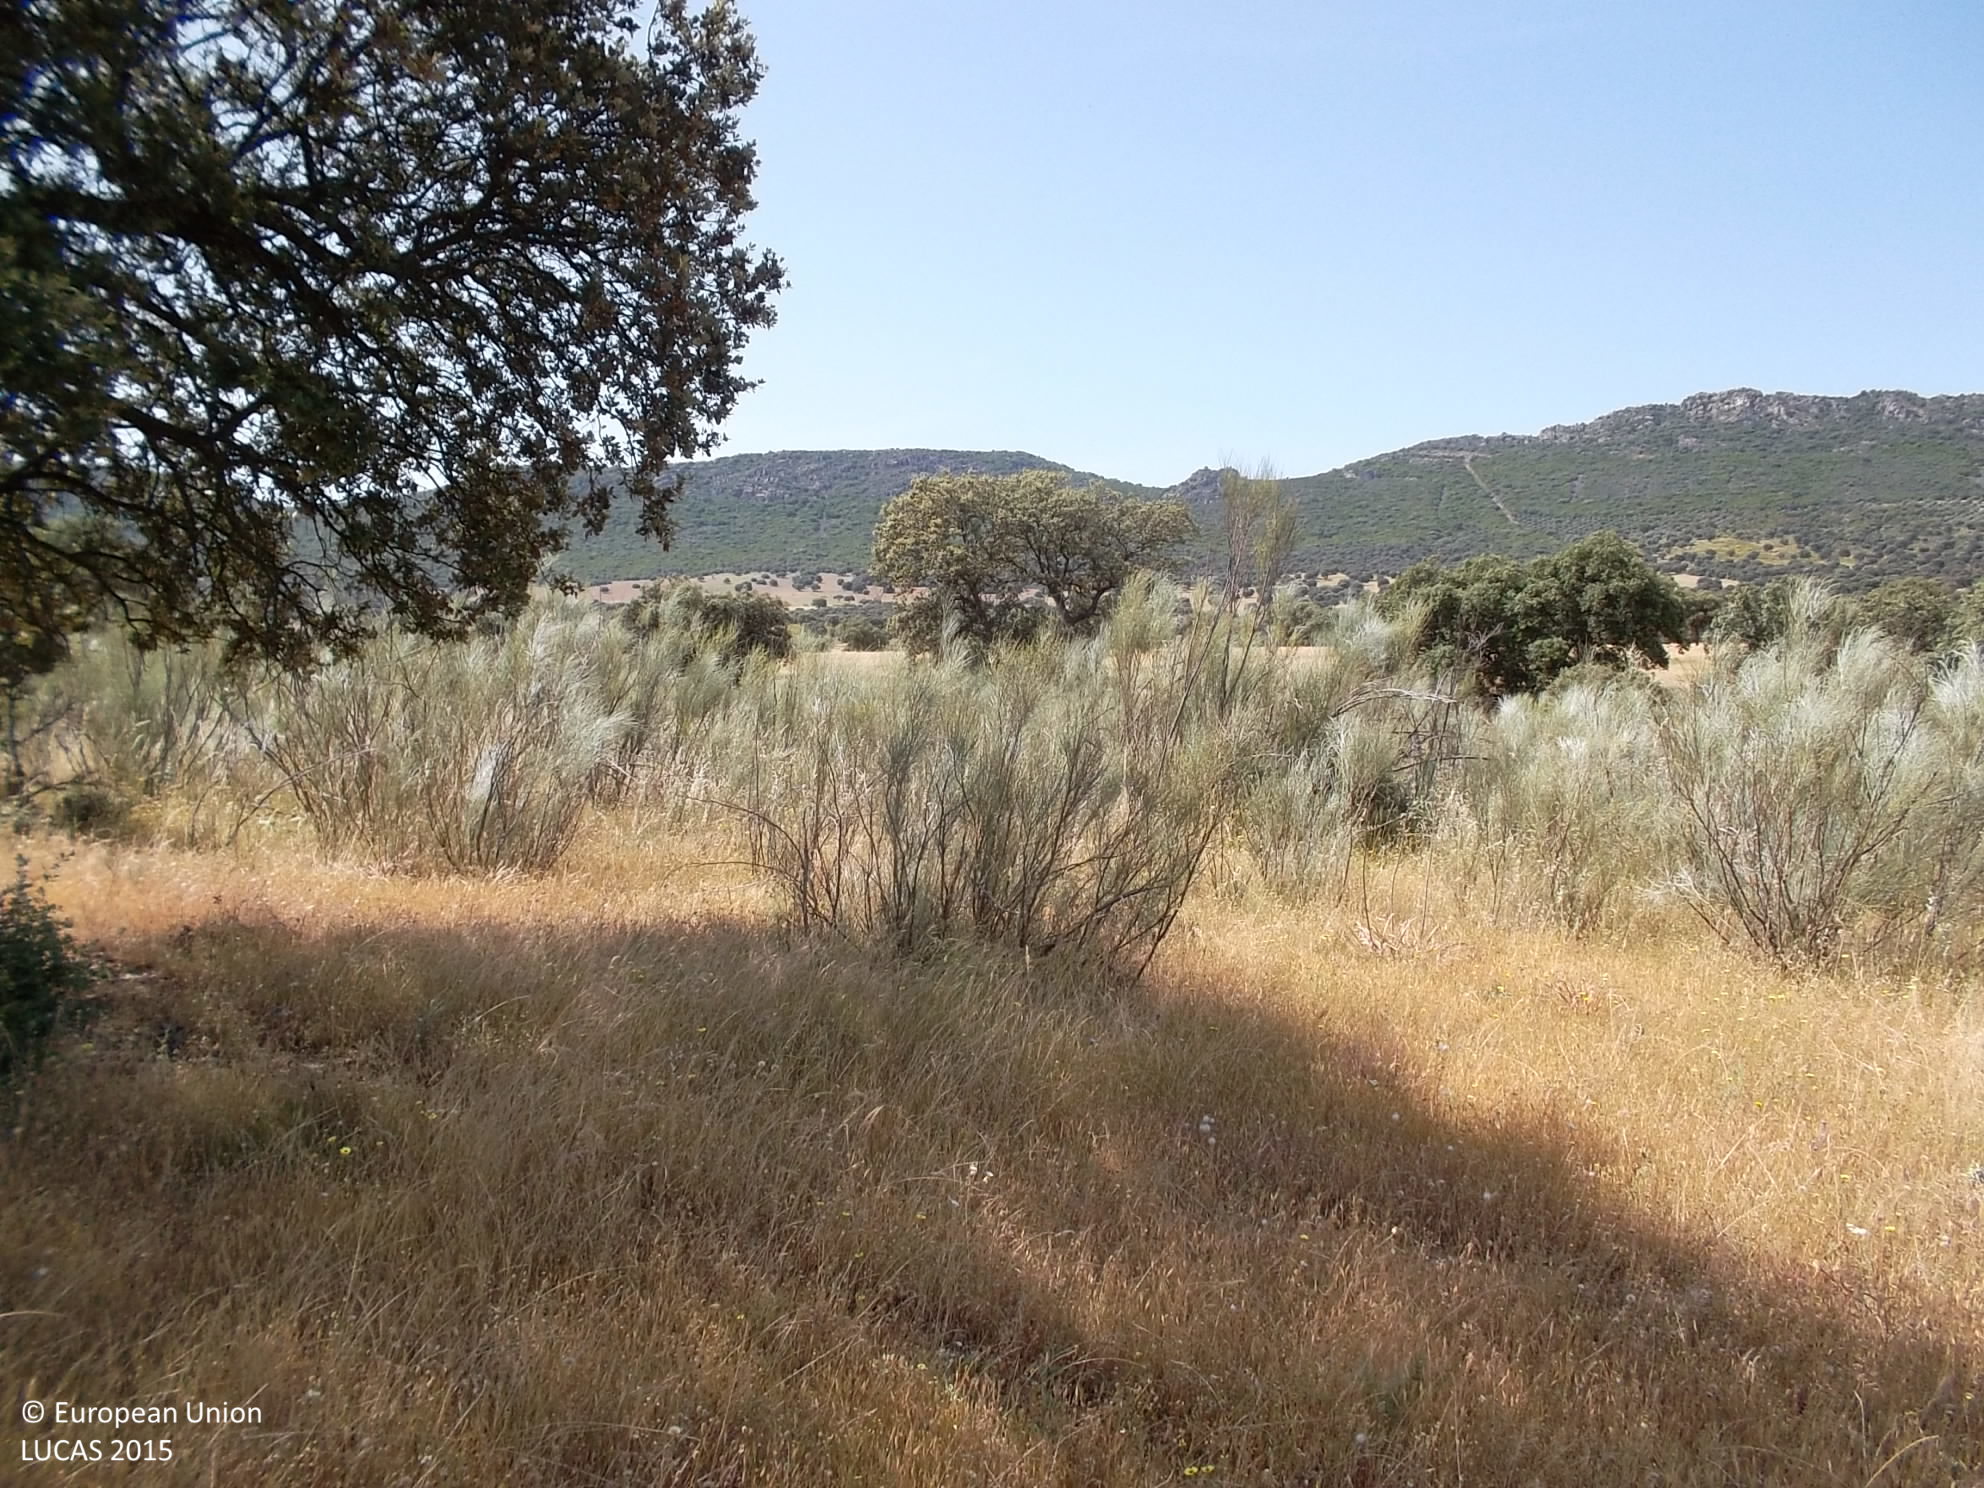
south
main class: Woodland
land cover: Broadleaved woodland
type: broadleaved evergreen forest
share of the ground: 10 - 25 %
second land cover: Shrubland without tree cover
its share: 50 - 75 %
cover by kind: herbaceous plants 55 %, shrubs 30 %, broadleaved forest trees 15 %
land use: Forestry
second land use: Agriculture (excluding fallow land and kitchen gardens)
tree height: > 5 m
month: May
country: ES
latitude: 38.6539
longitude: -4.7229
